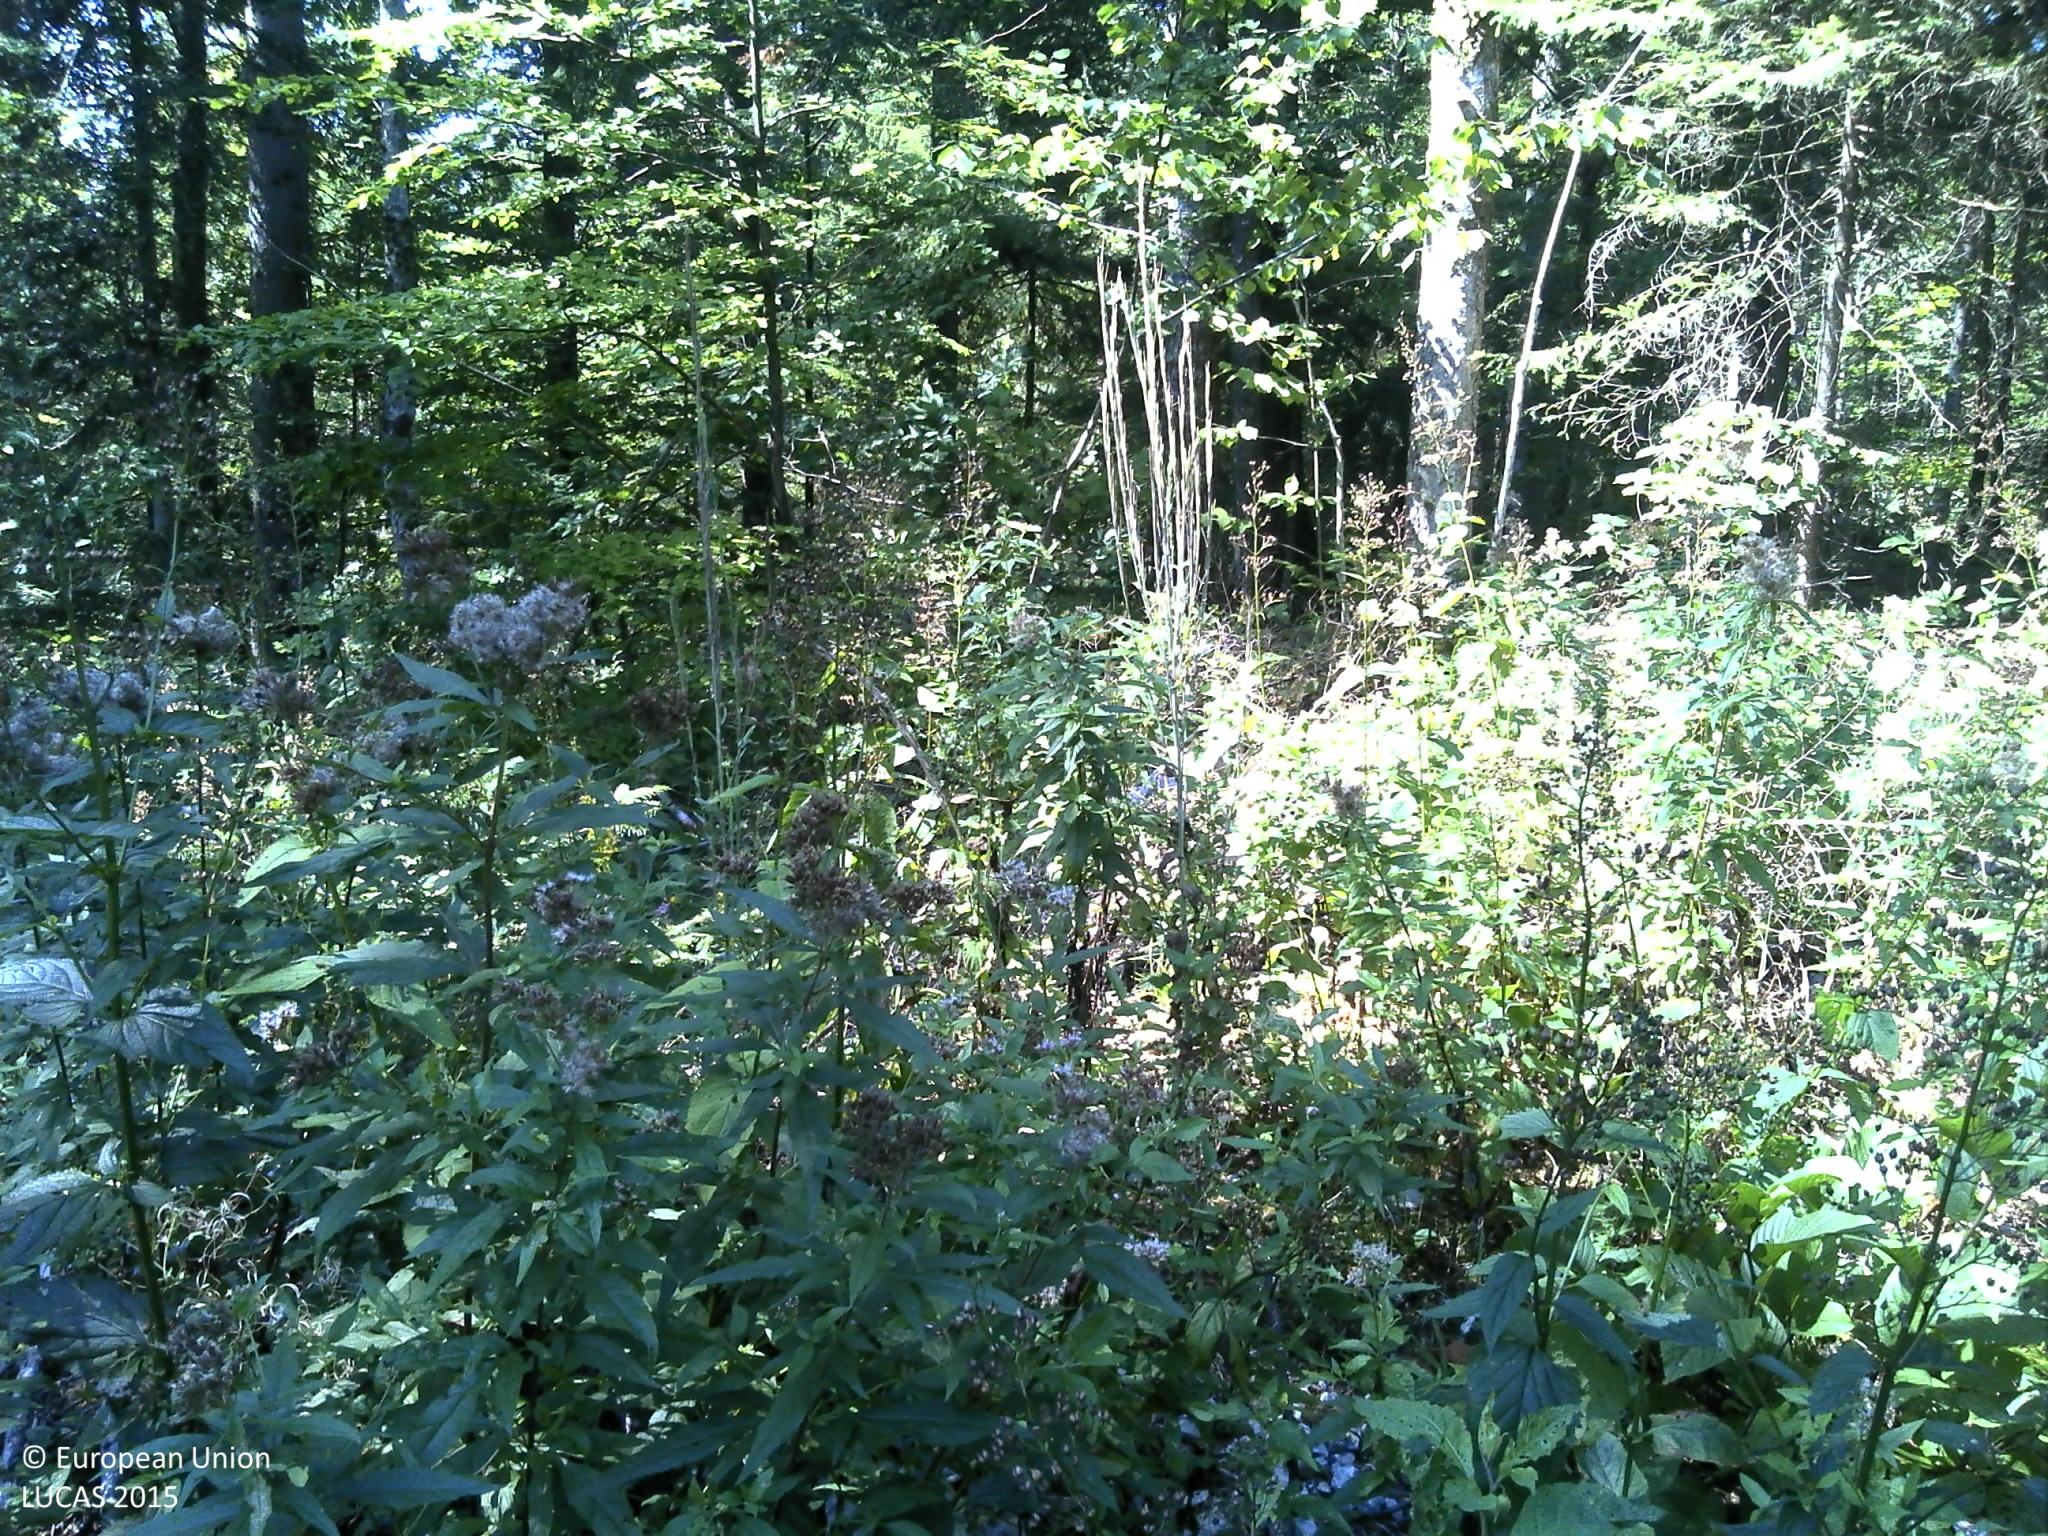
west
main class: Woodland
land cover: Pine dominated coniferous woodland
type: coniferous forest of the mediterranean region
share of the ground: > 75 %
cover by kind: coniferous forest trees 100 %
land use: Forestry
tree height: > 5 m
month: August
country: HR
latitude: 45.1597
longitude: 15.1979
